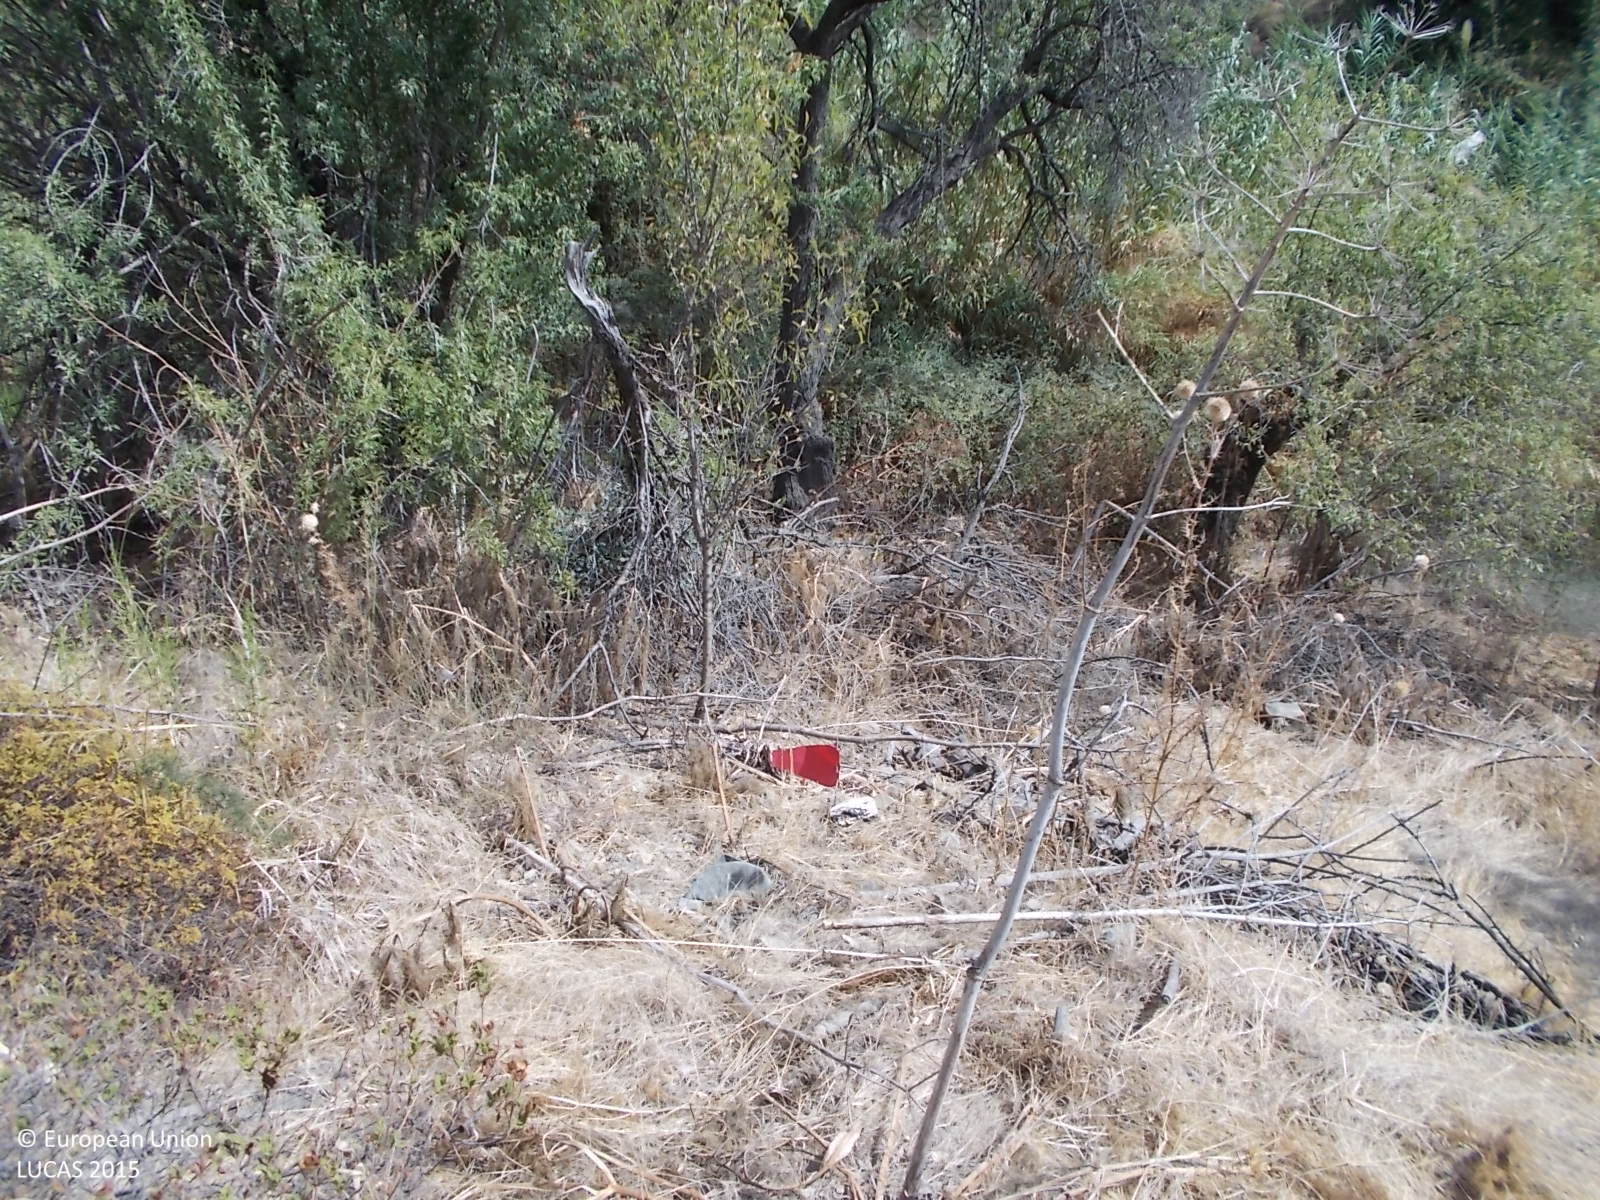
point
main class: Cropland
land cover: Nuts trees
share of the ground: 25 - 50 %
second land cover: Spontaneously vegetated surfaces
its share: > 75 %
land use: Abandoned areas
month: April
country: CY
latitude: 34.8659
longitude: 33.1583
